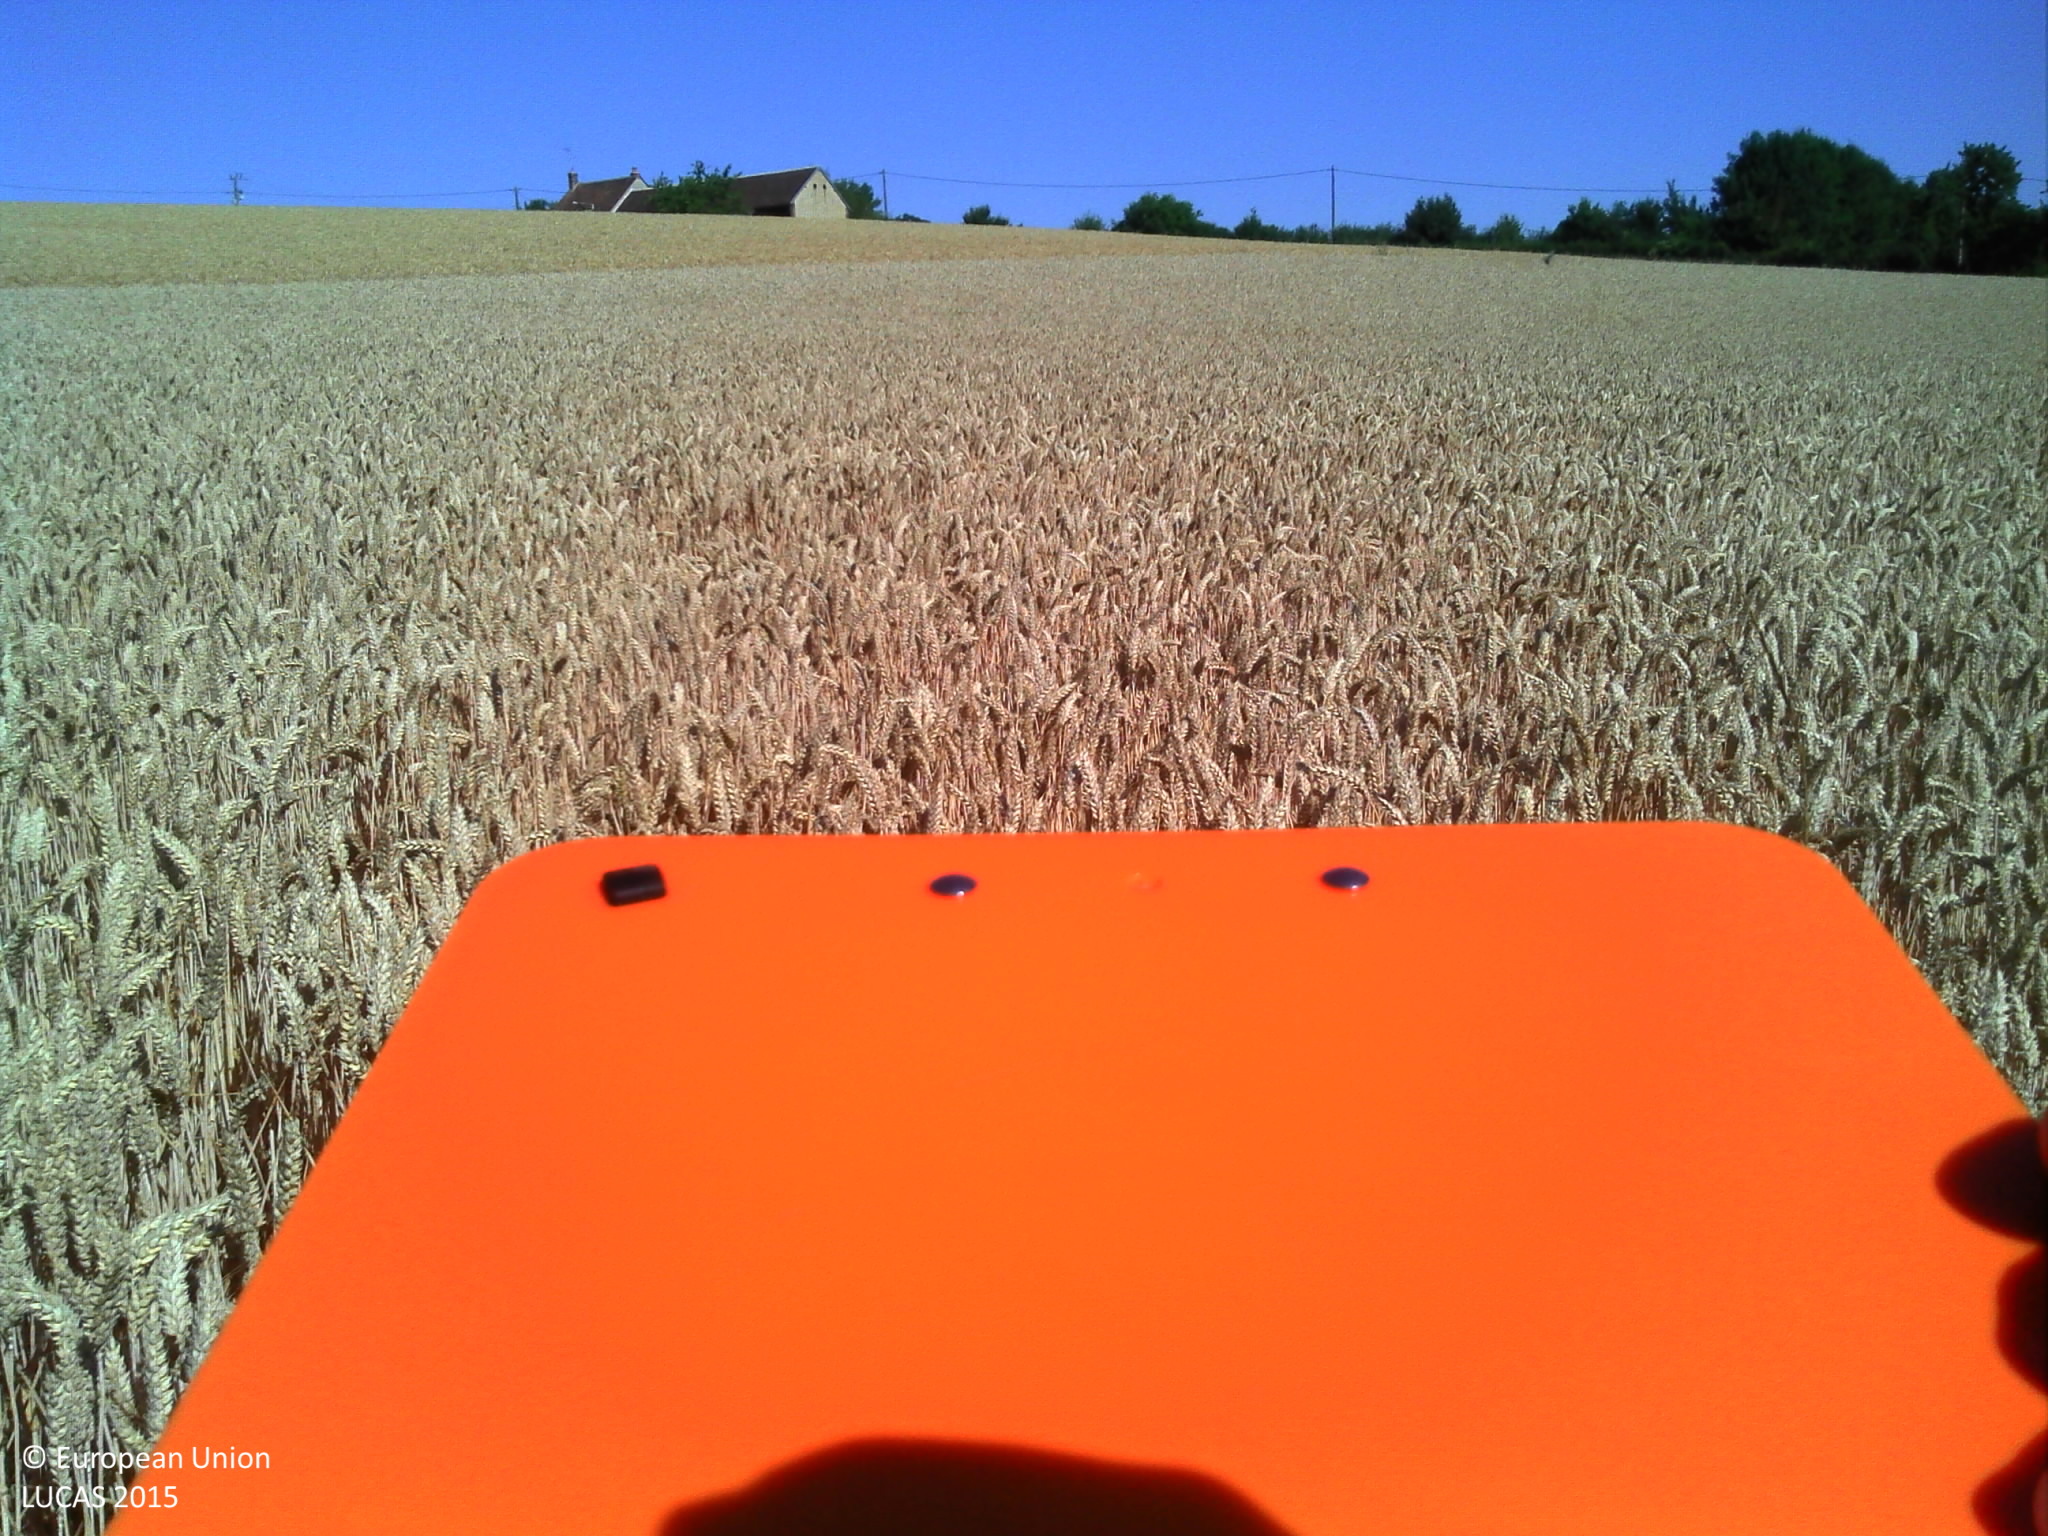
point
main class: Cropland
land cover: Common wheat
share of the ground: > 75 %
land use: Agriculture (excluding fallow land and kitchen gardens)
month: July
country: FR
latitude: 47.9316
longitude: 3.0465
